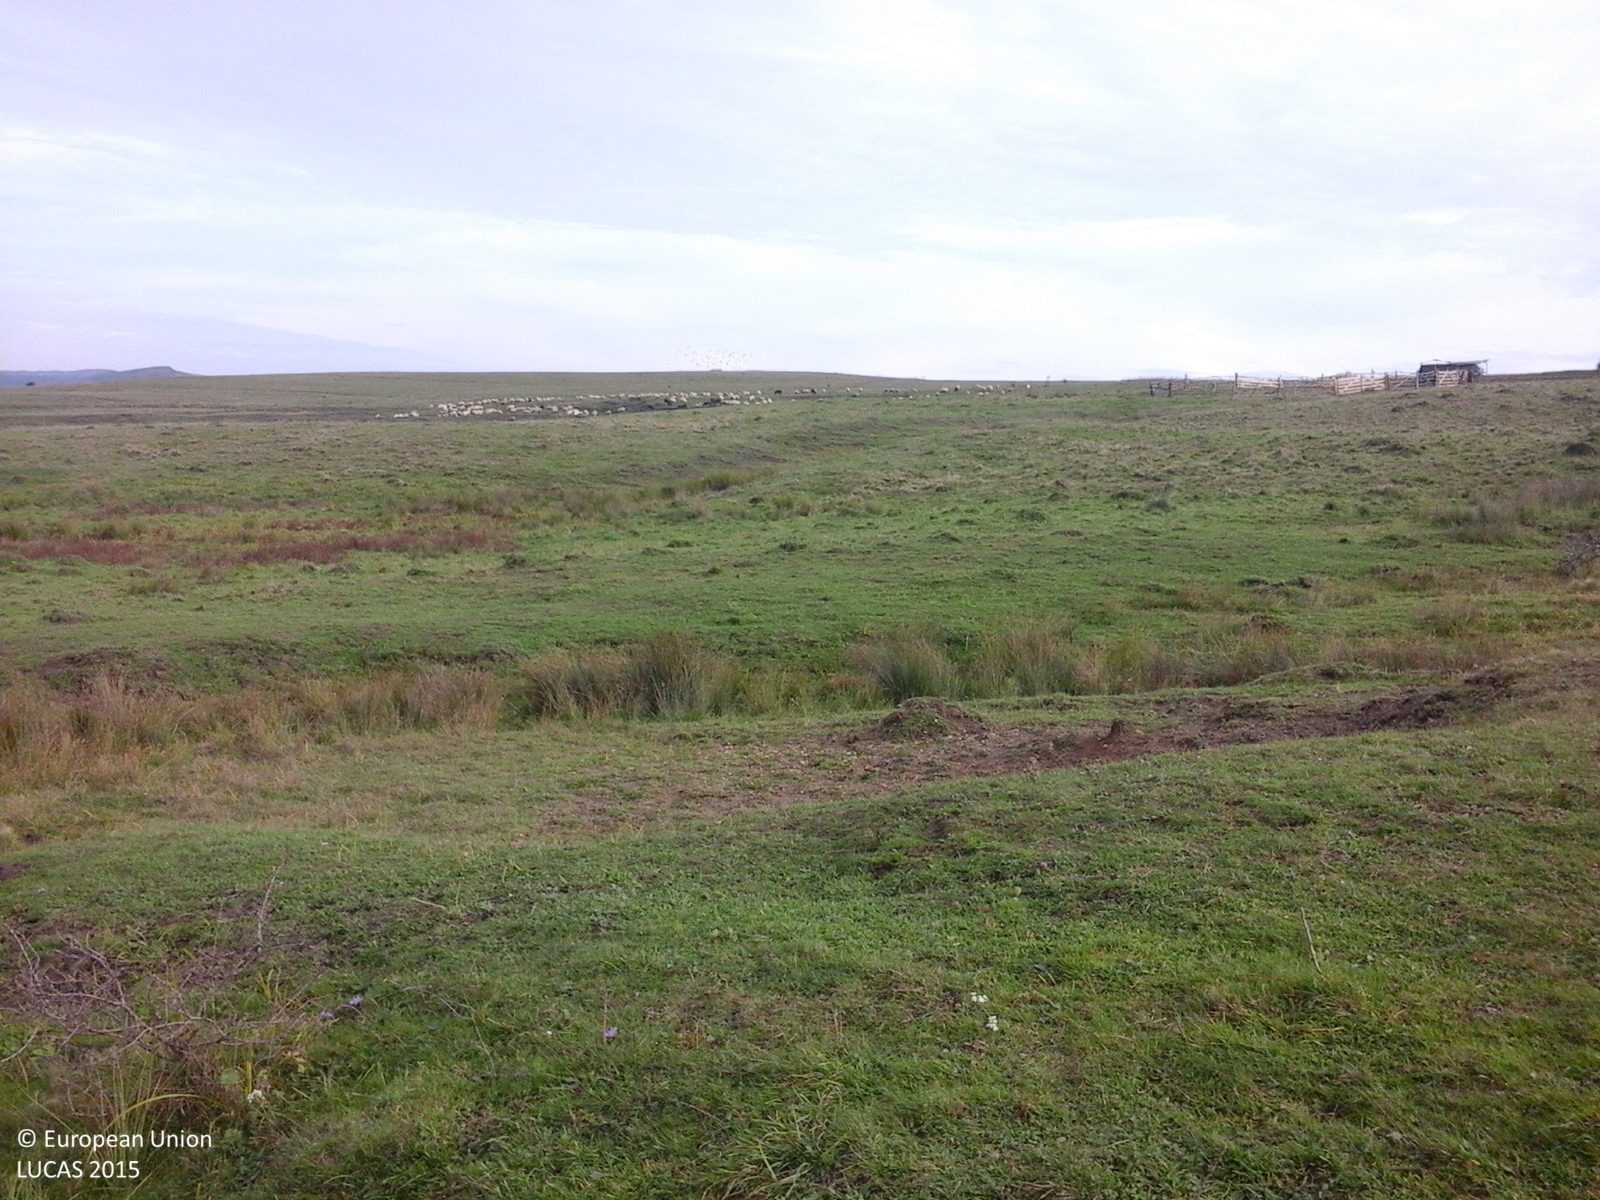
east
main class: Grassland
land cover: Grassland without tree/shrub cover
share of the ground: > 75 %
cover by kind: herbaceous plants 100 %
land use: Agriculture (excluding fallow land and kitchen gardens)
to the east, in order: Grassland without tree/shrub cover
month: October
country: RO
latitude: 45.9849
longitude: 24.9771
